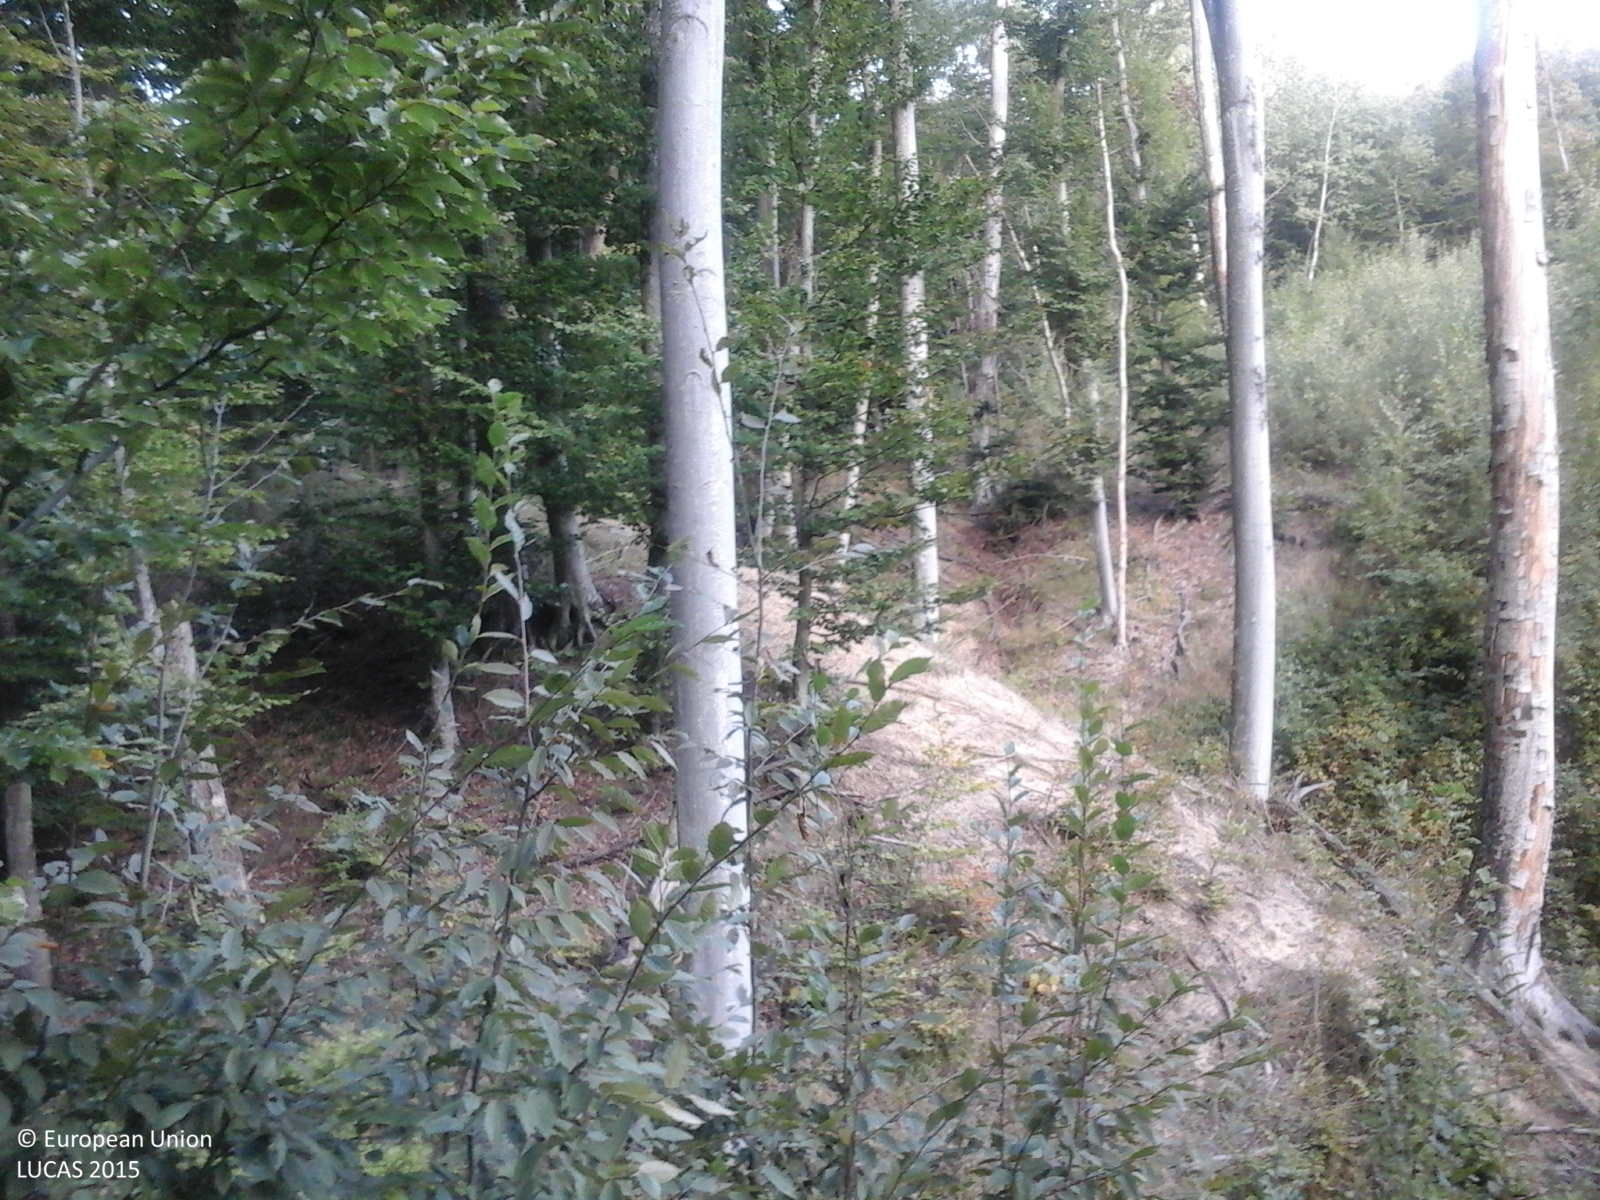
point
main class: Woodland
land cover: Broadleaved woodland
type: acidophilous oak and oak-birch forest
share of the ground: > 75 %
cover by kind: broadleaved forest trees 100 %
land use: Forestry
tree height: > 5 m
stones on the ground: < 10 %
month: September
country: RO
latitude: 45.7185
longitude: 22.0789
